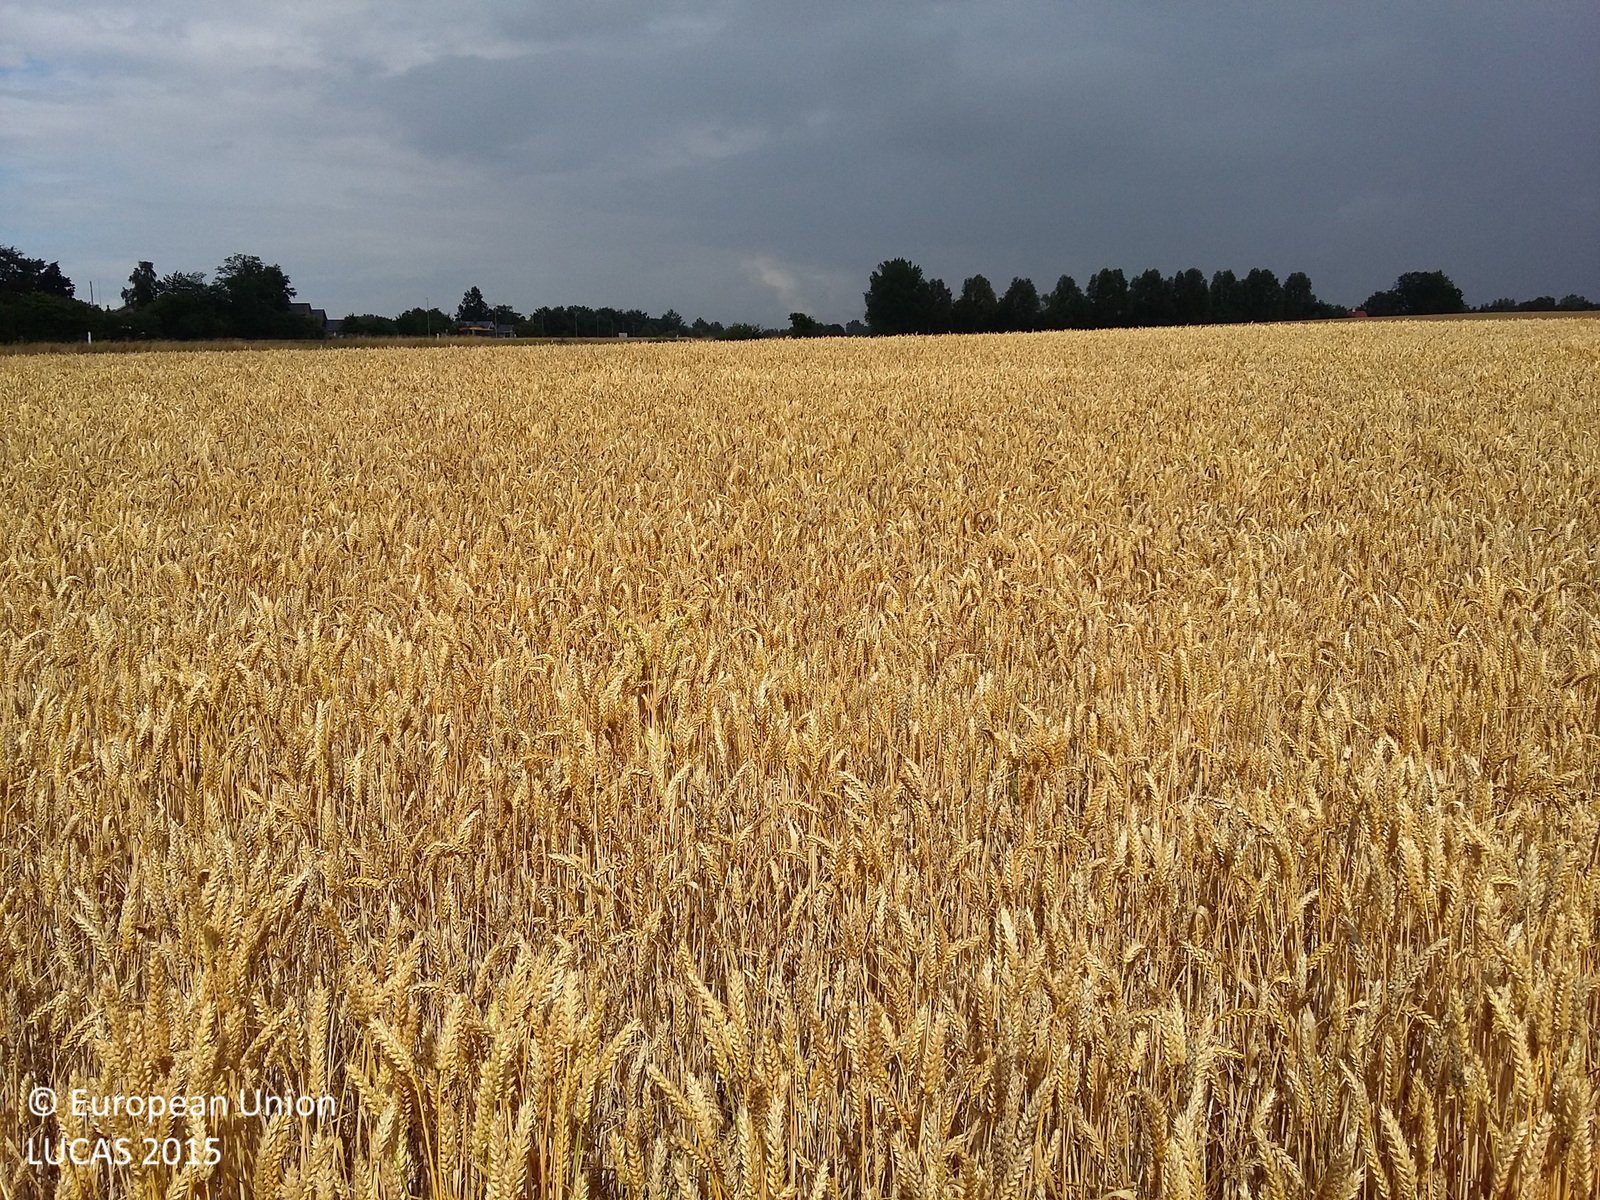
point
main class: Cropland
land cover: Common wheat
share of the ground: > 75 %
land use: Agriculture (excluding fallow land and kitchen gardens)
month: July
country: DK
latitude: 55.7741
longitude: 12.1502
